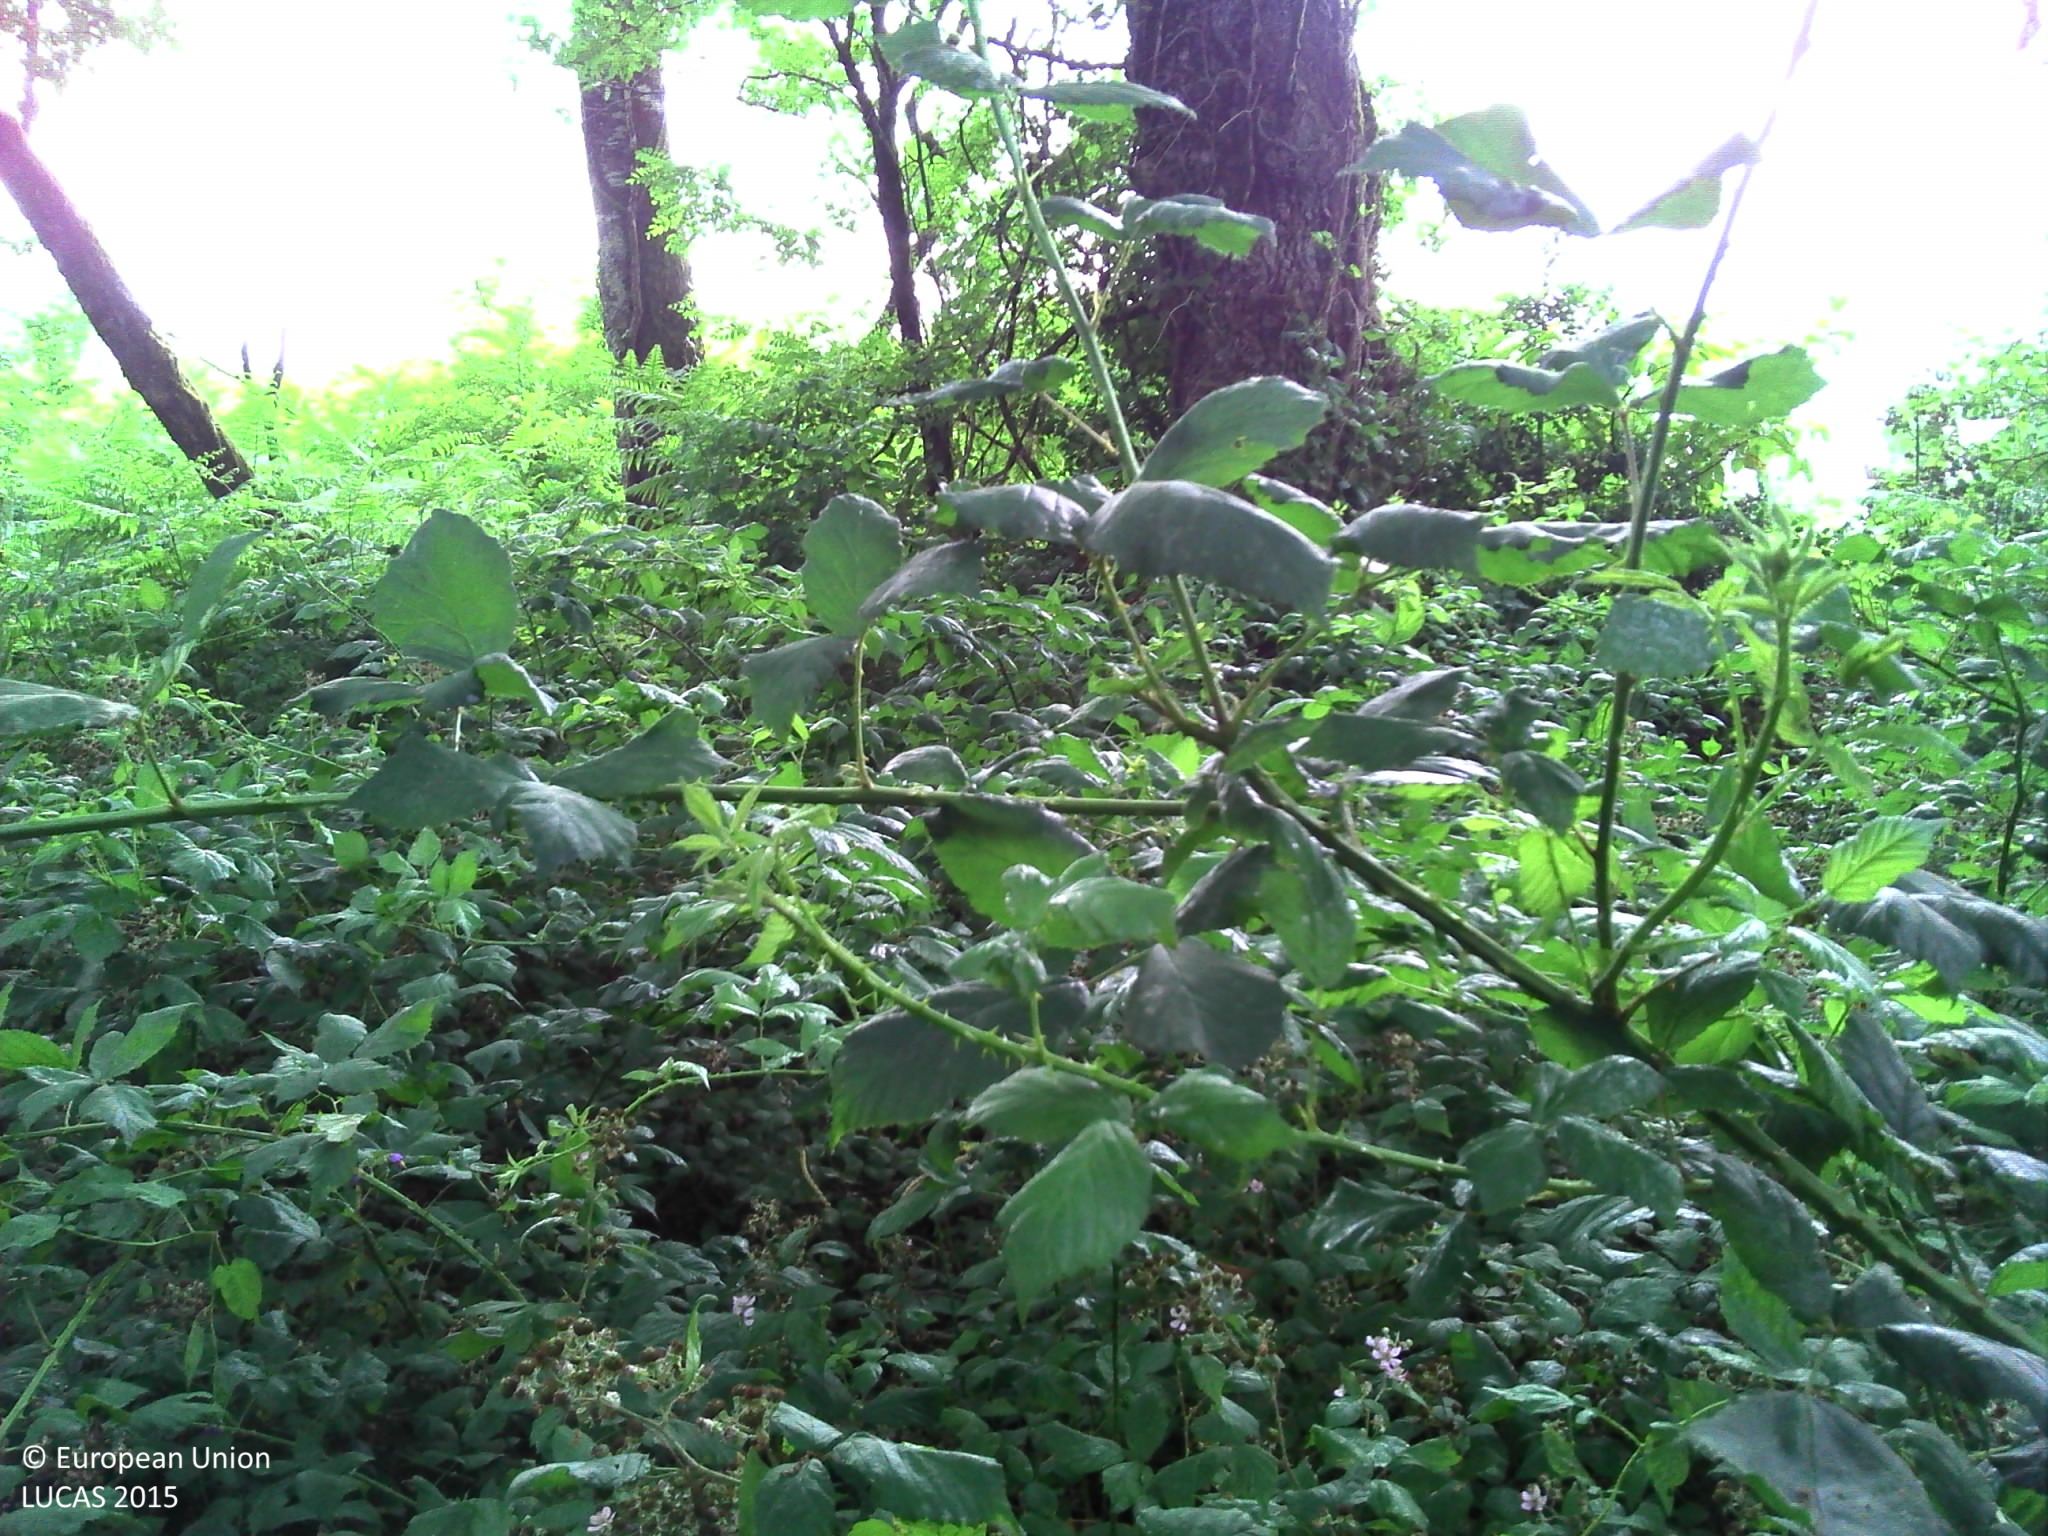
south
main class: Woodland
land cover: Broadleaved woodland
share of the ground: 25 - 50 %
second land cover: Spontaneously vegetated surfaces
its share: 50 - 75 %
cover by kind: herbaceous plants 65 %, broadleaved forest trees 25 %
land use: Agriculture (excluding fallow land and kitchen gardens)
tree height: < 5 m
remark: Temporary flooded
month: July
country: FR
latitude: 45.7096
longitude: 0.7003
